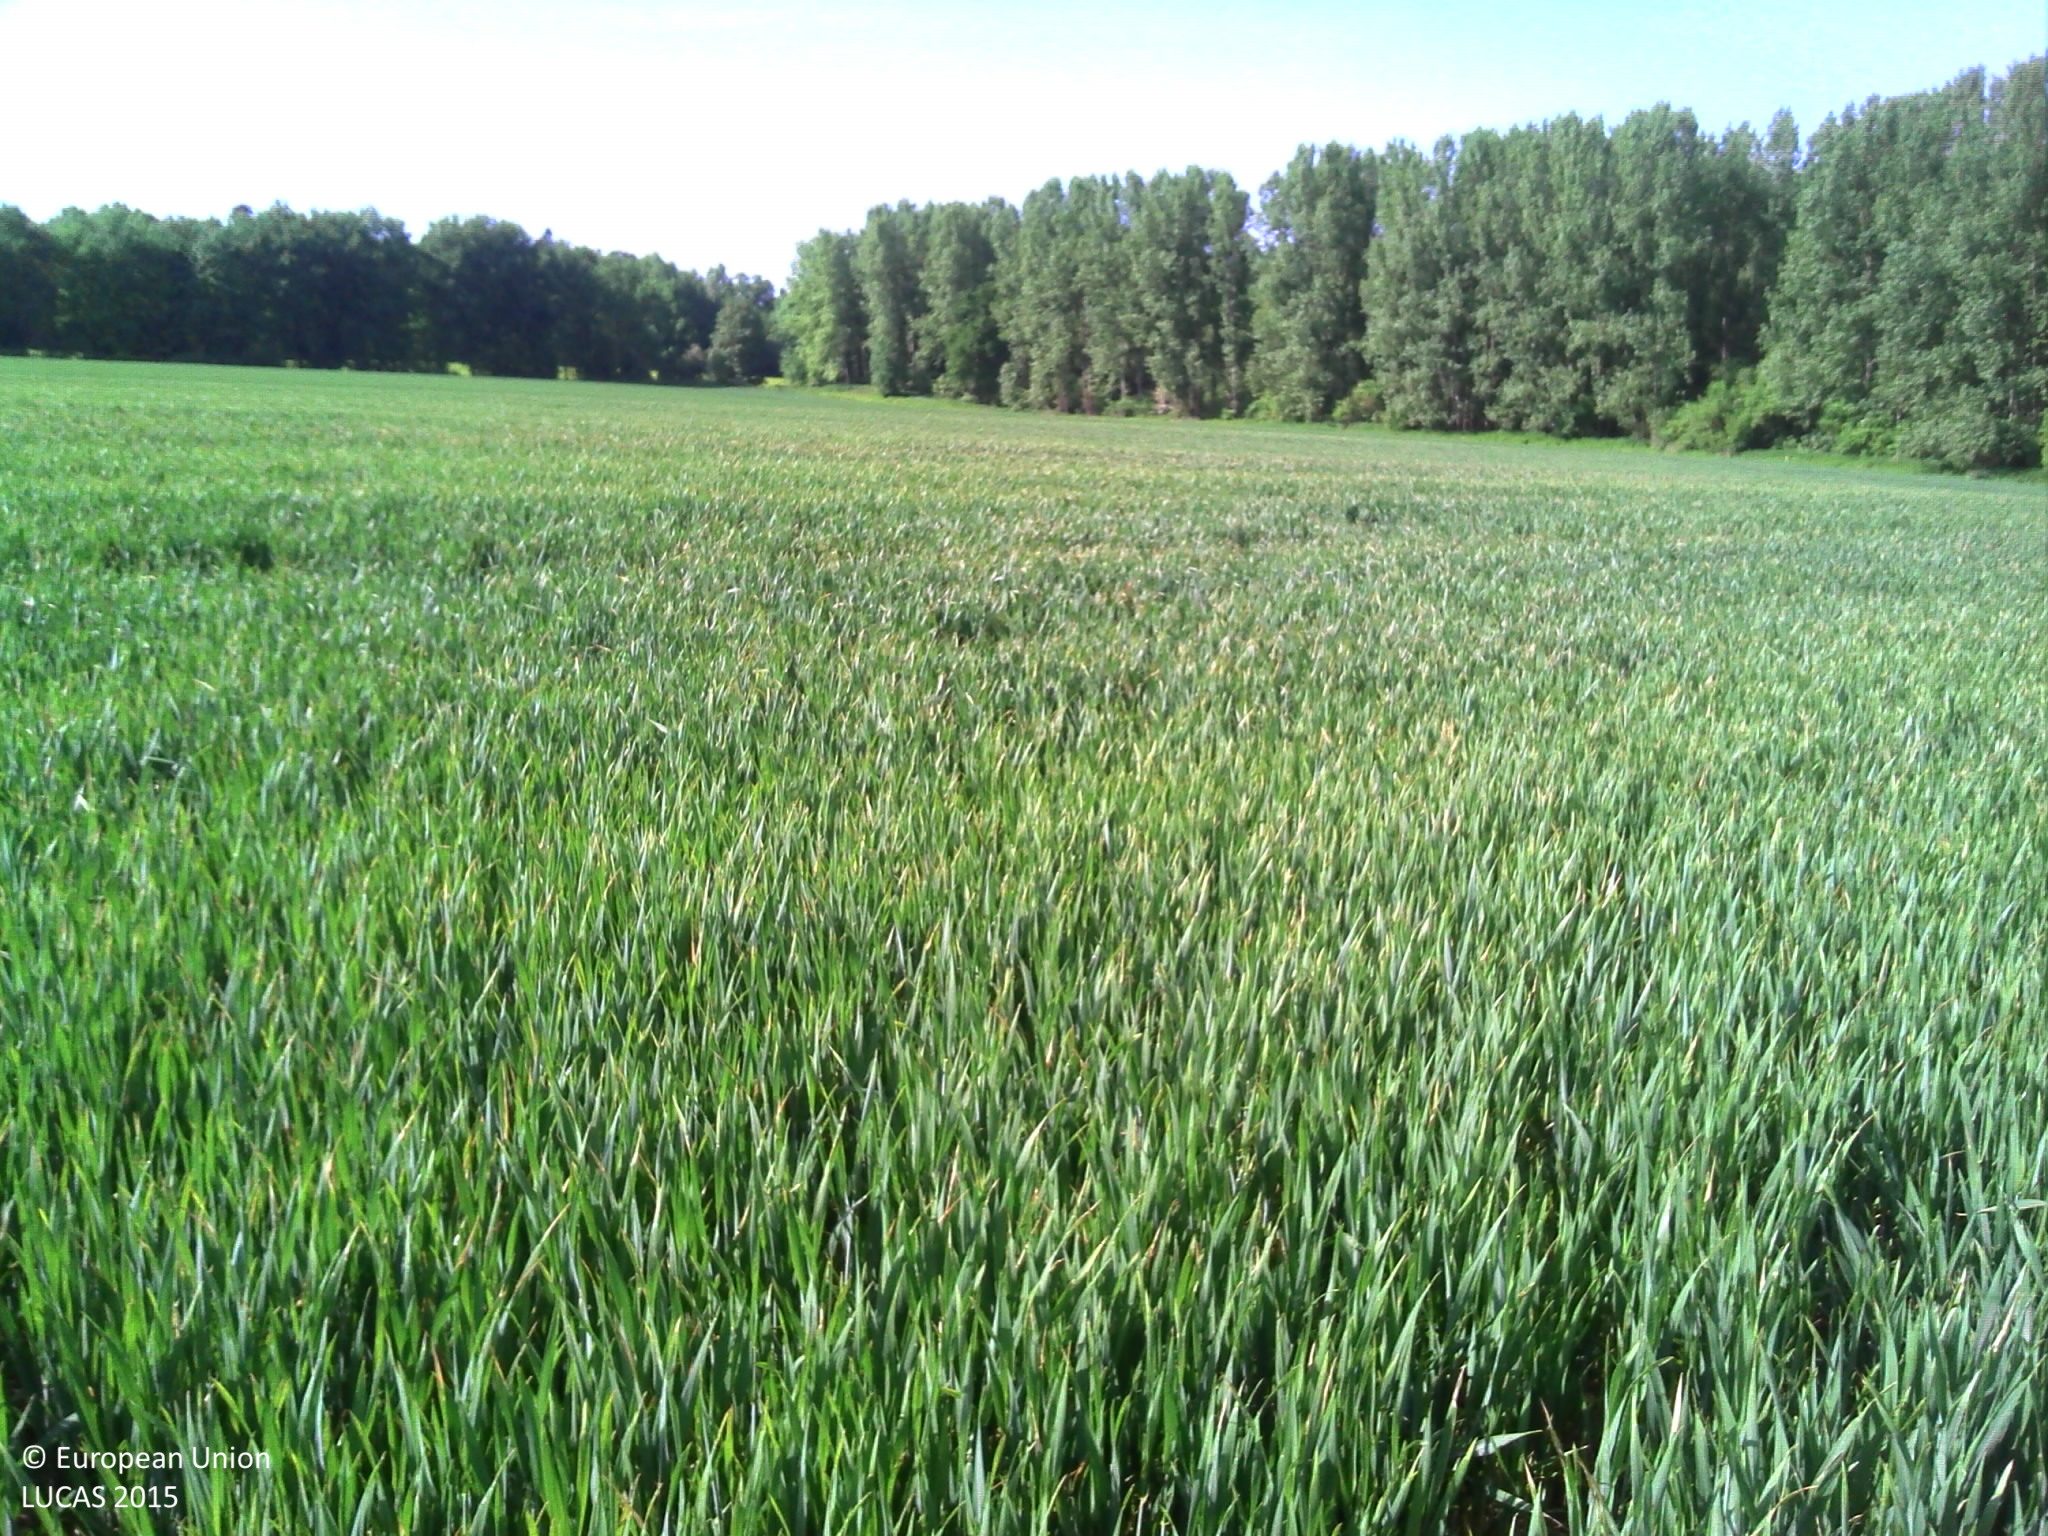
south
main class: Cropland
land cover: Common wheat
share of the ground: > 75 %
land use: Agriculture (excluding fallow land and kitchen gardens)
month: May
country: BE
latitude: 50.5631
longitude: 4.6458
